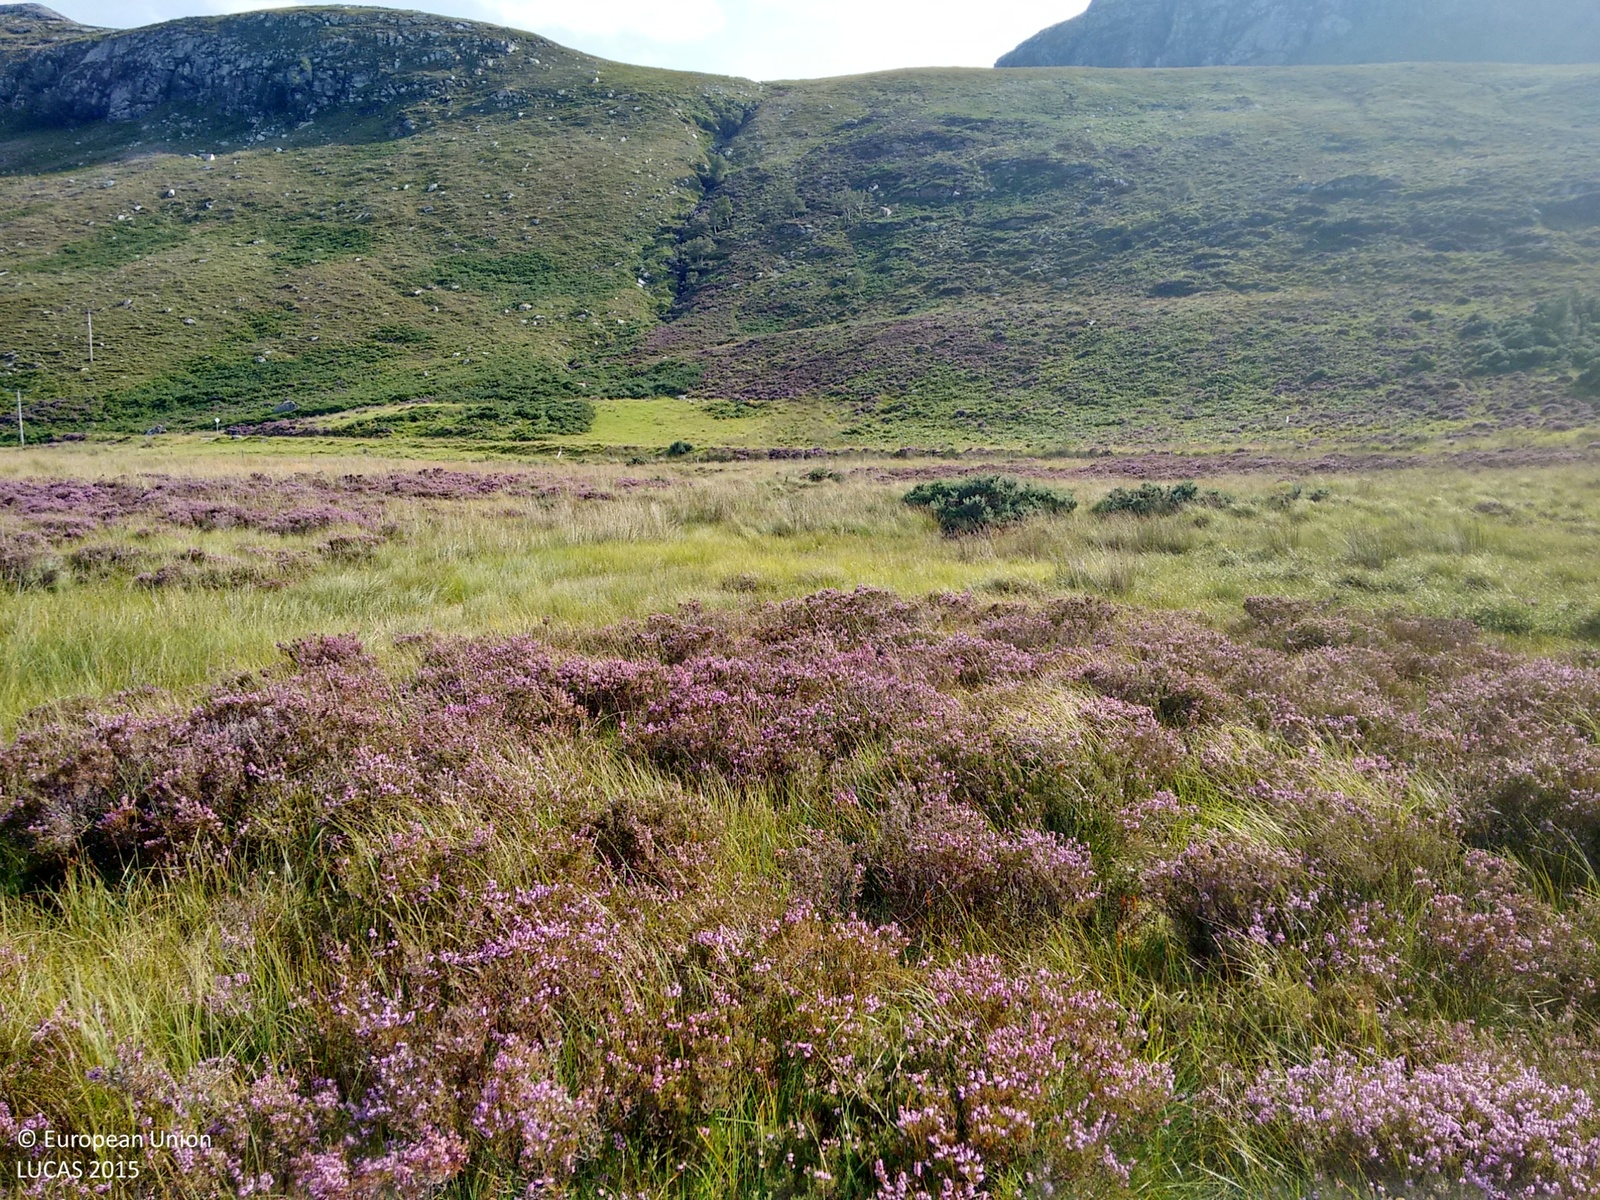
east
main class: Shrubland
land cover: Shrubland without tree cover
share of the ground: > 75 %
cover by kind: shrubs 90 %, herbaceous plants 10 %
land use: Agriculture (excluding fallow land and kitchen gardens)
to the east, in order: Shrubland without tree cover; Grassland without tree/shrub cover; Rivers and streams; Grassland without tree/shrub cover; Shrubland without tree cover; Fences; Grass margins; Paved roads, cycling and walking lanes; Grassland without tree/shrub cover; Shrubland without tree cover; Shrubland with sparse tree cover; Rivers and streams; Shrubland without tree cover
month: September
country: GB
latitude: 58.4457
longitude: -4.7392
